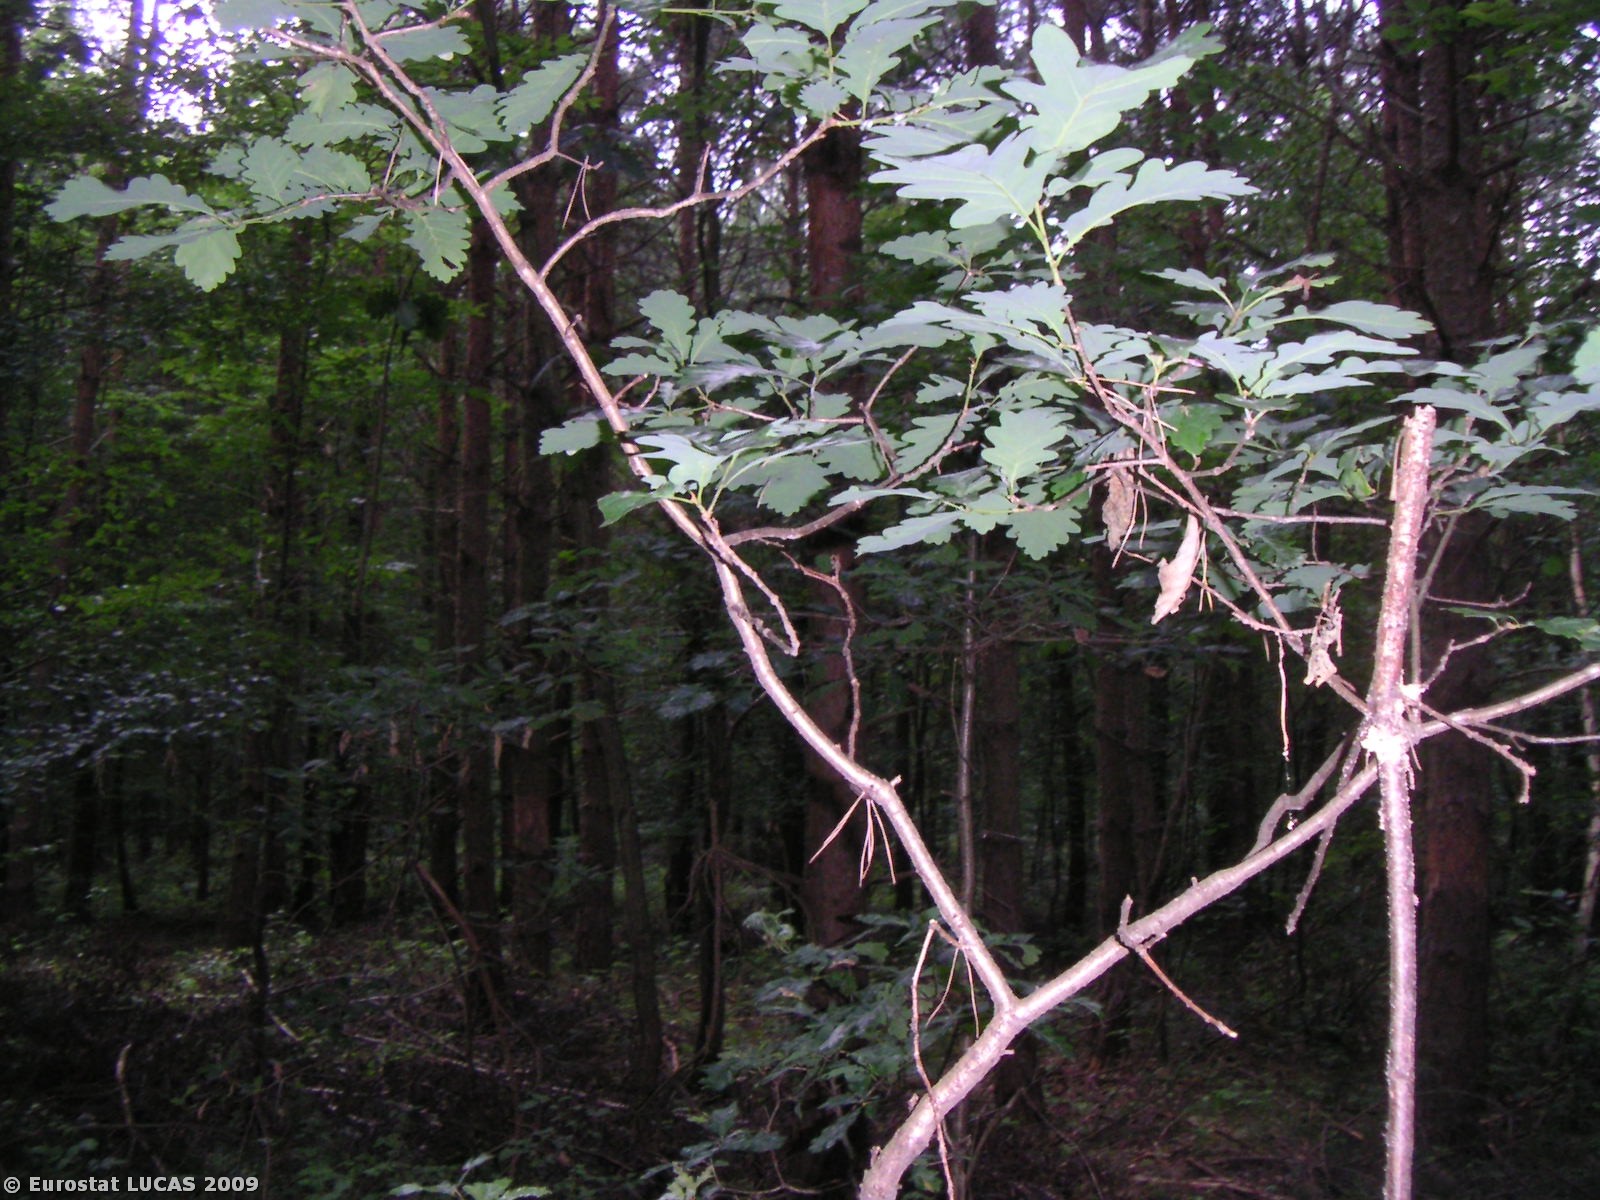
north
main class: Woodland
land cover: Coniferous woodland
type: hemiboreal forest and nemoral coniferous forest and mixed broadleaved-coniferous forest
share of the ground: > 75 %
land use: Forestry
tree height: > 5 m
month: July
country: PL
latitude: 50.5441
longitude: 19.7529
